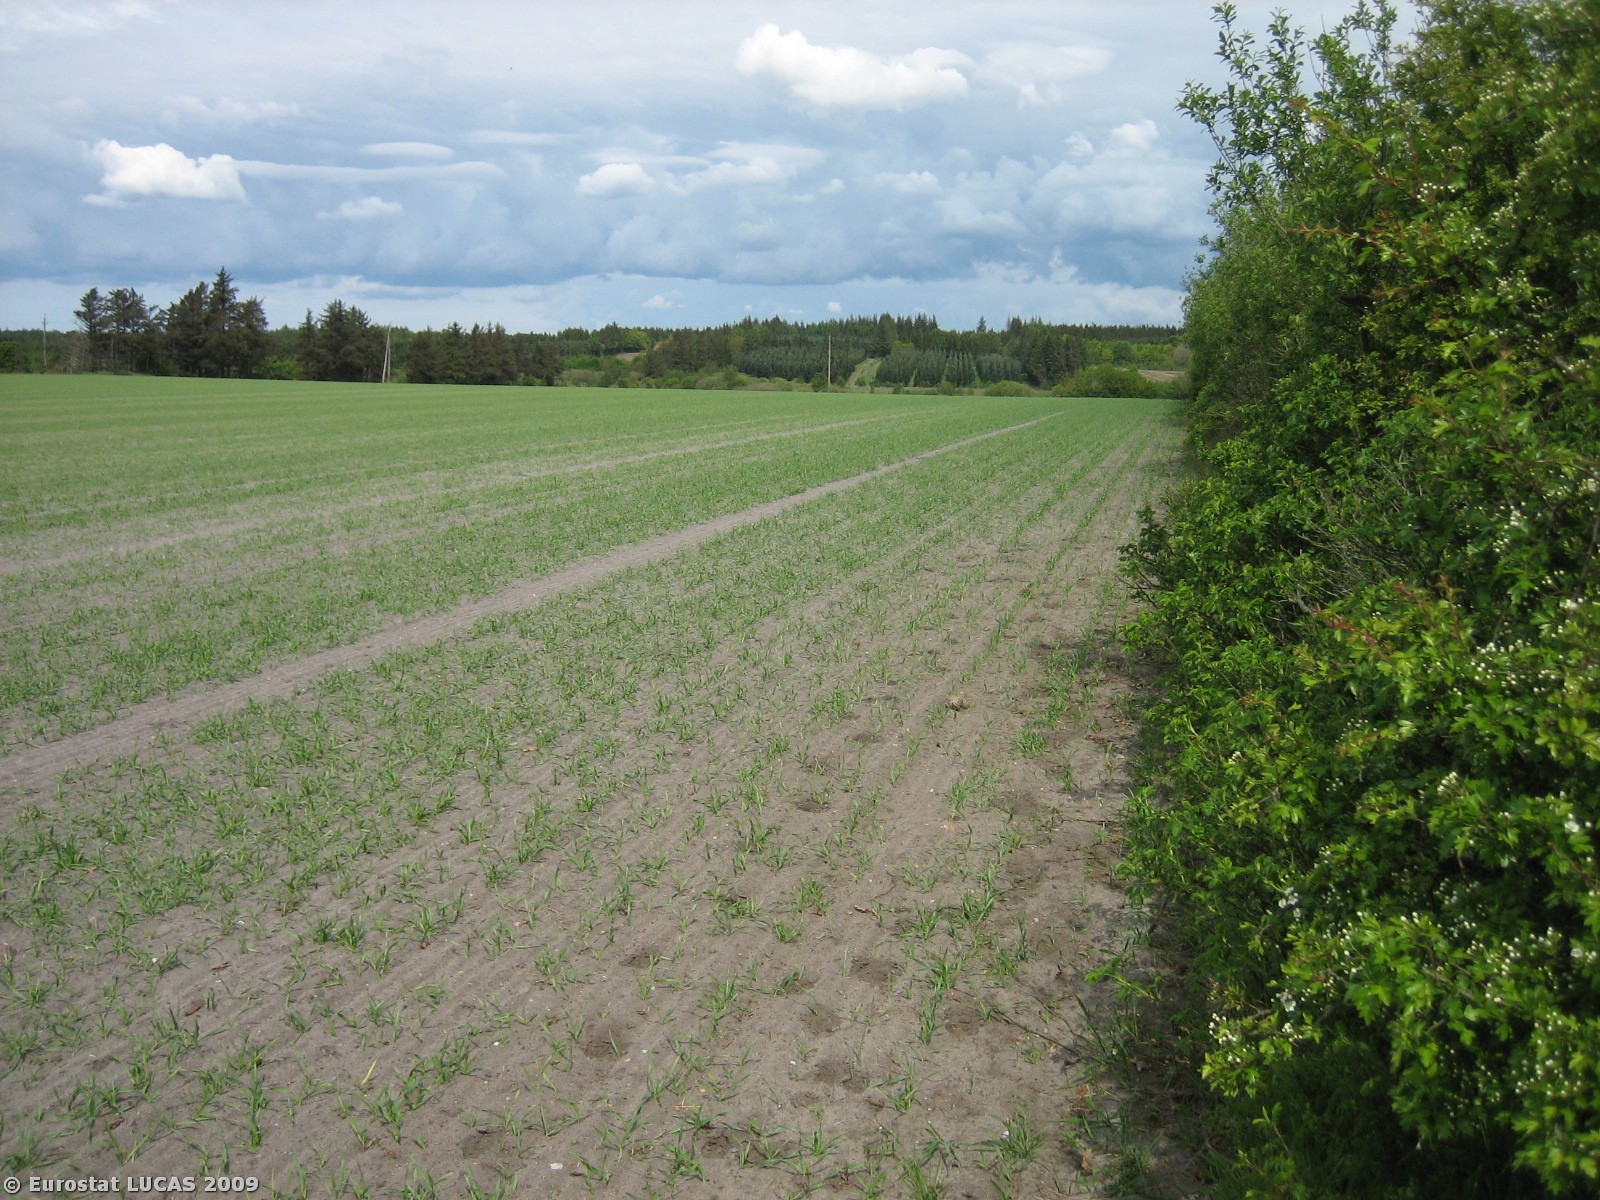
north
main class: Shrubland
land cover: Shrubland with sparse tree cover
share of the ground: > 75 %
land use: Unused
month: May
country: DK
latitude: 56.1958
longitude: 8.4062
